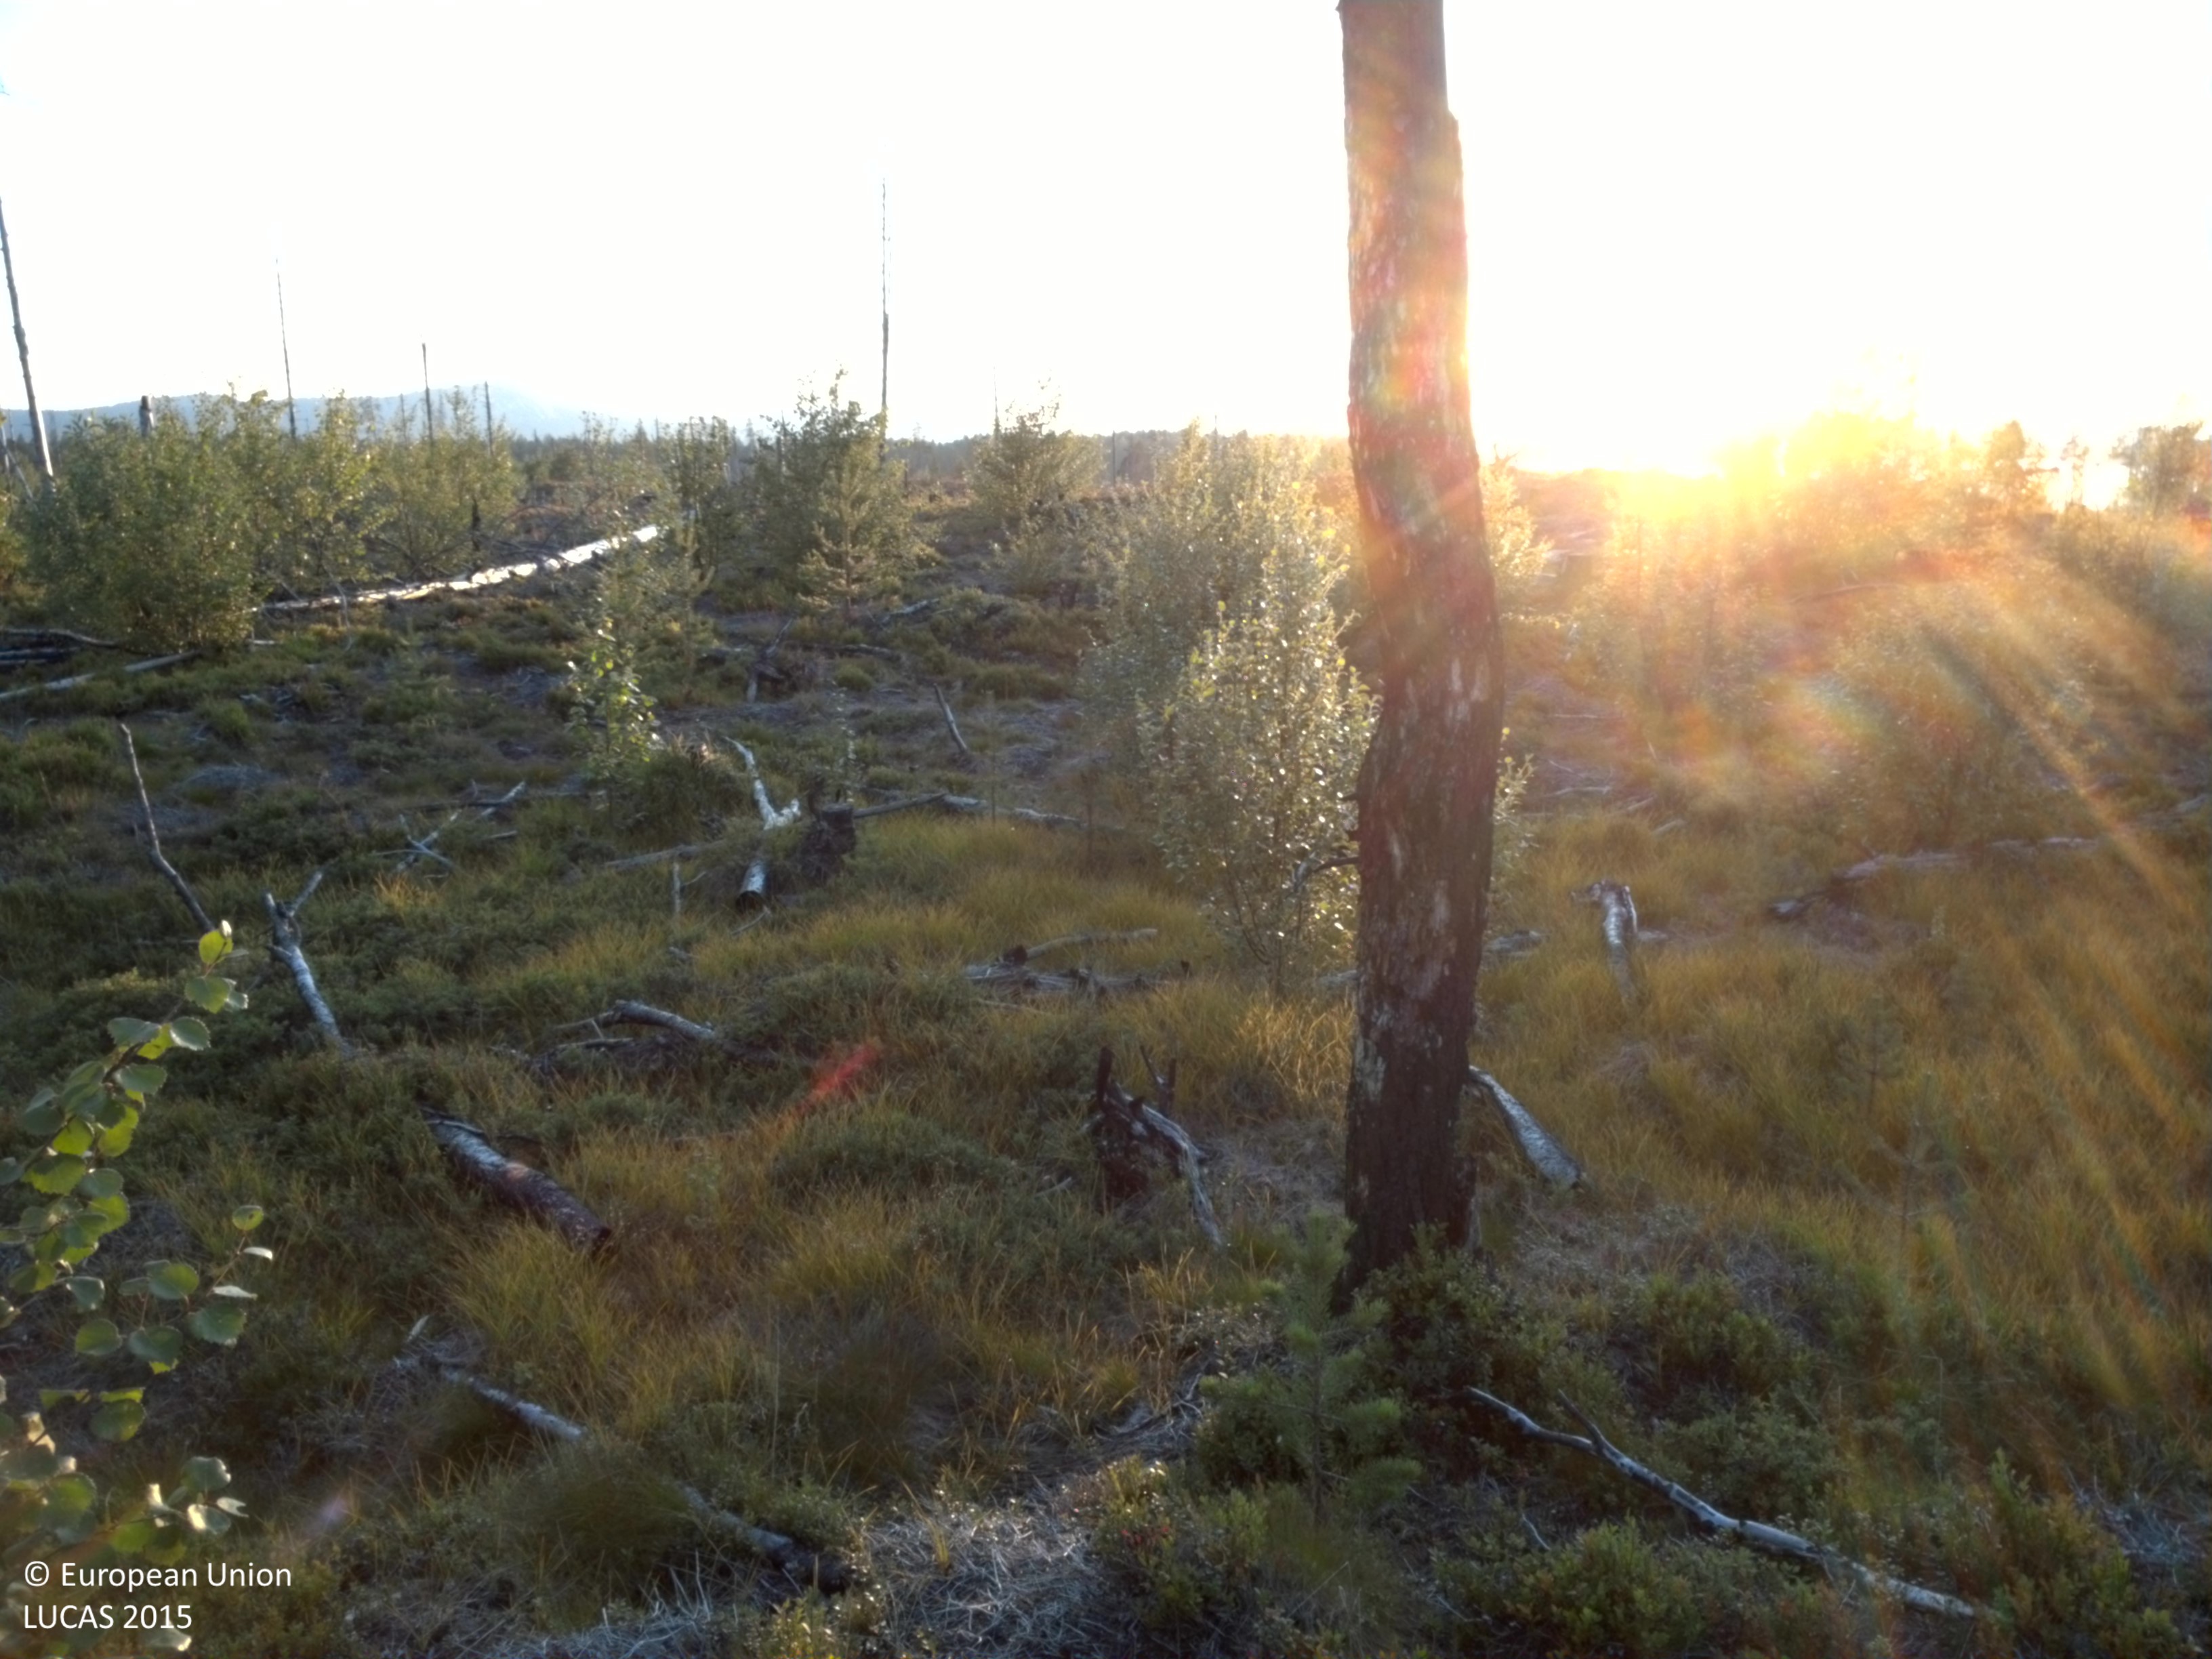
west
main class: Woodland
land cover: Broadleaved woodland
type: boreal forest
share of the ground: 10 - 25 %
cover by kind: shrubs 65 %, broadleaved forest trees 15 %, lichens and mosses 15 %
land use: Forestry
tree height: < 5 m
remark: Clear cut
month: August
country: SE
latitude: 66.6326
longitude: 19.1010
